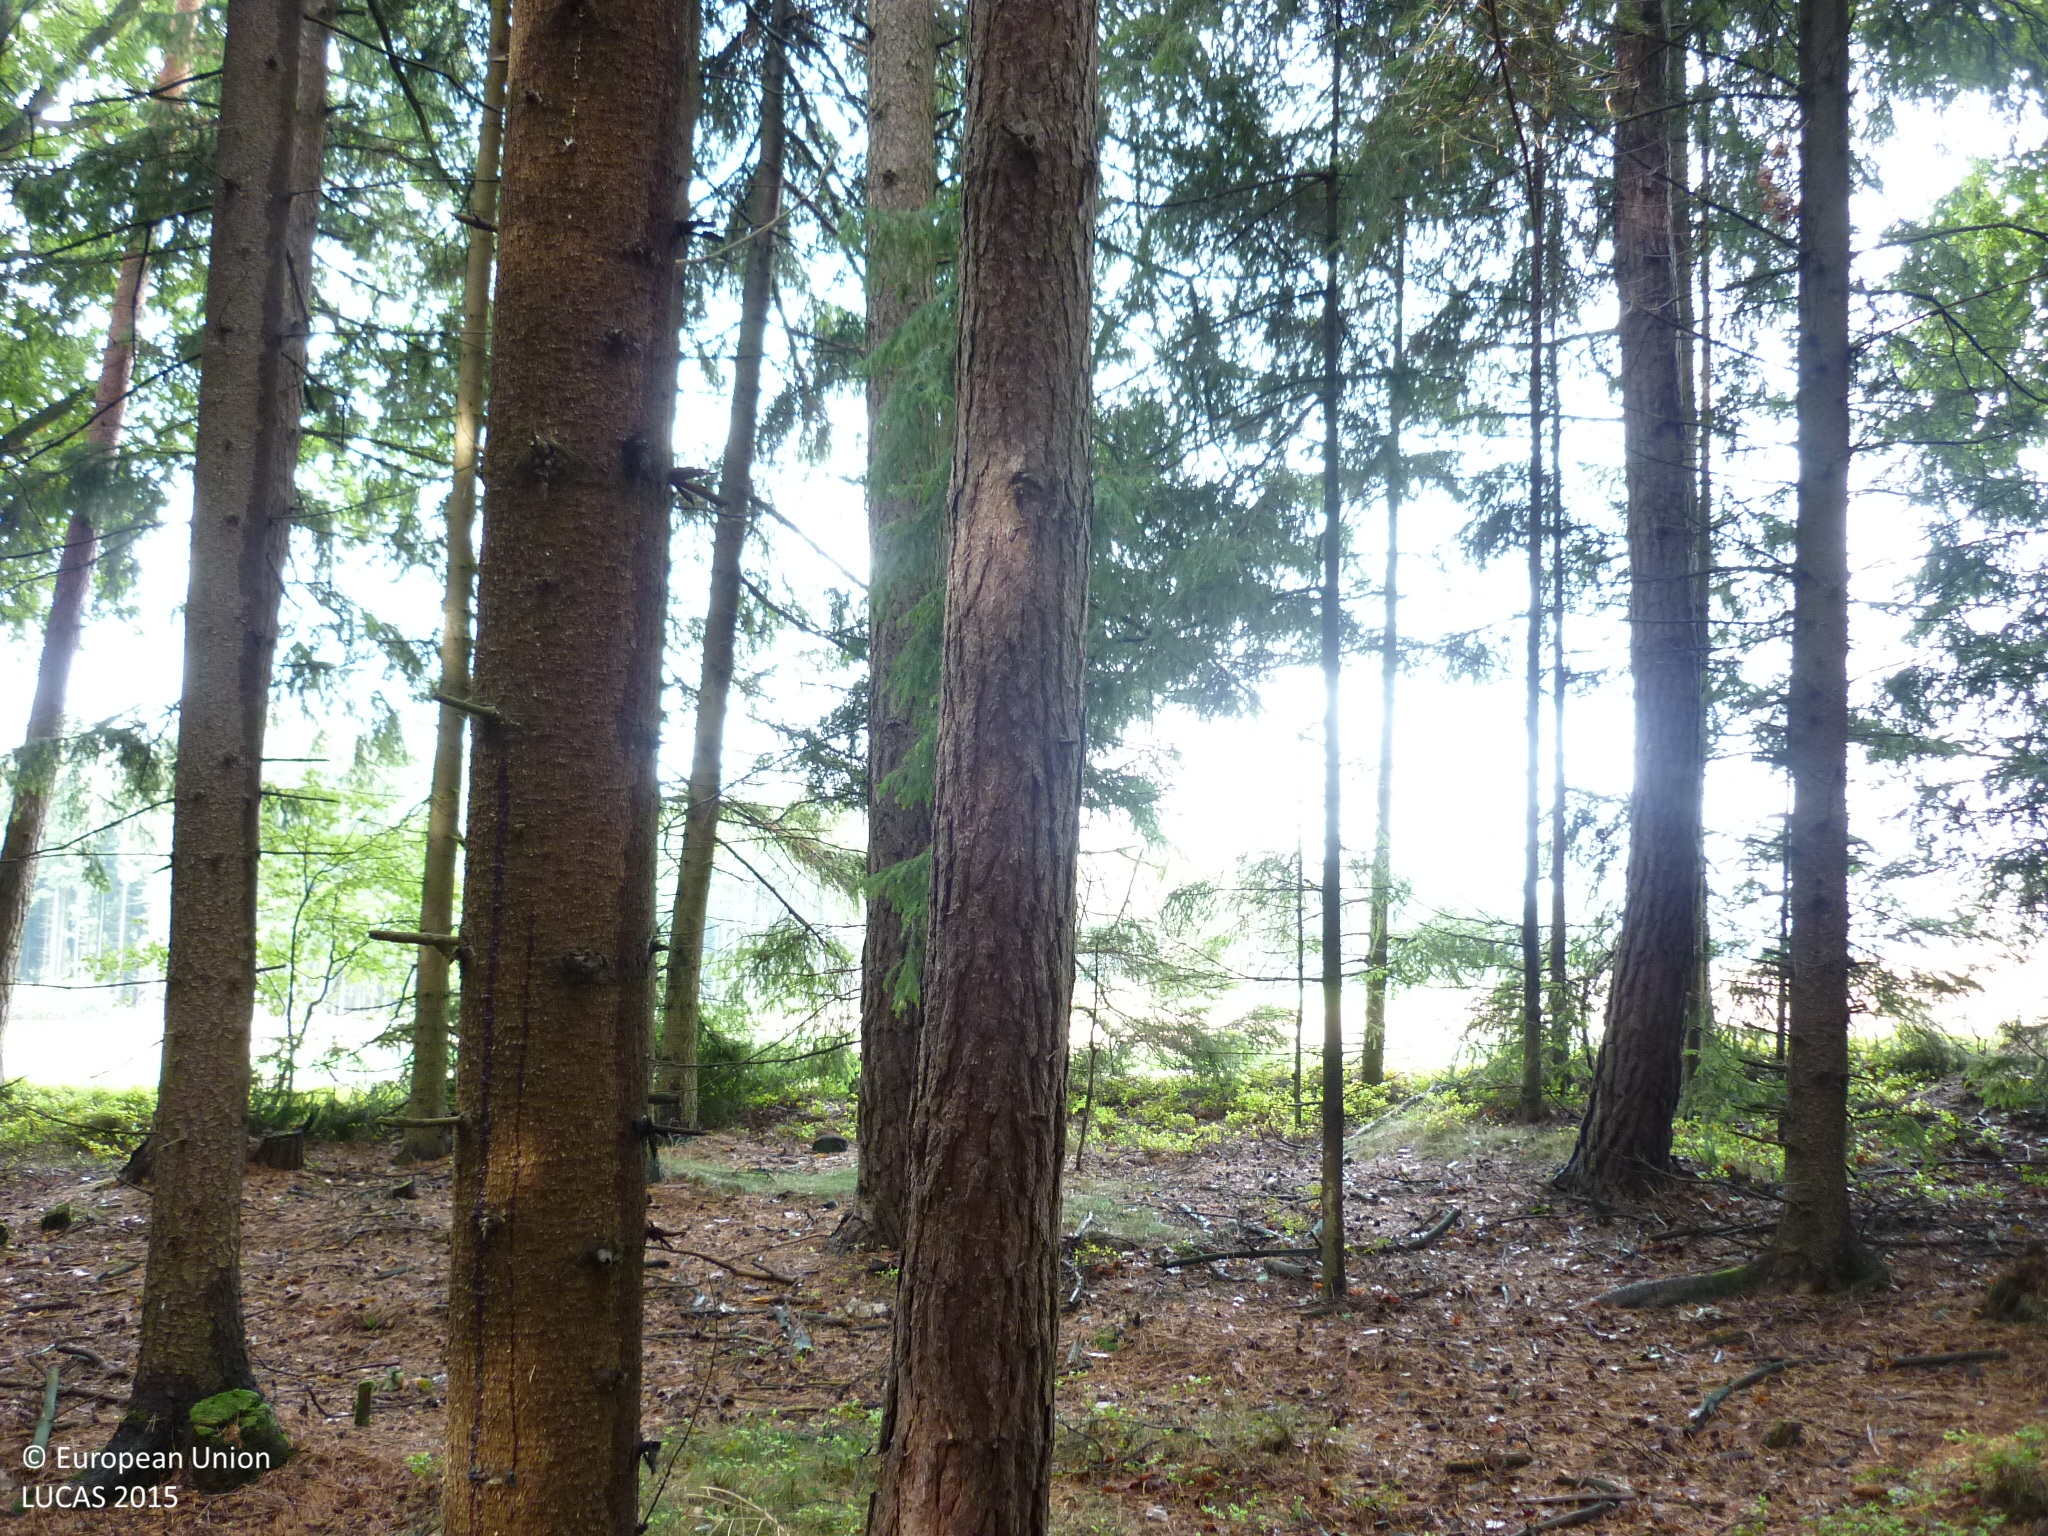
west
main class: Woodland
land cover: Spruce dominated coniferous woodland
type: hemiboreal forest and nemoral coniferous forest and mixed broadleaved-coniferous forest
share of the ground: > 75 %
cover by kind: coniferous forest trees 100 %
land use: Forestry
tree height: > 5 m
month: September
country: AT
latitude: 48.9543
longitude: 15.0687
